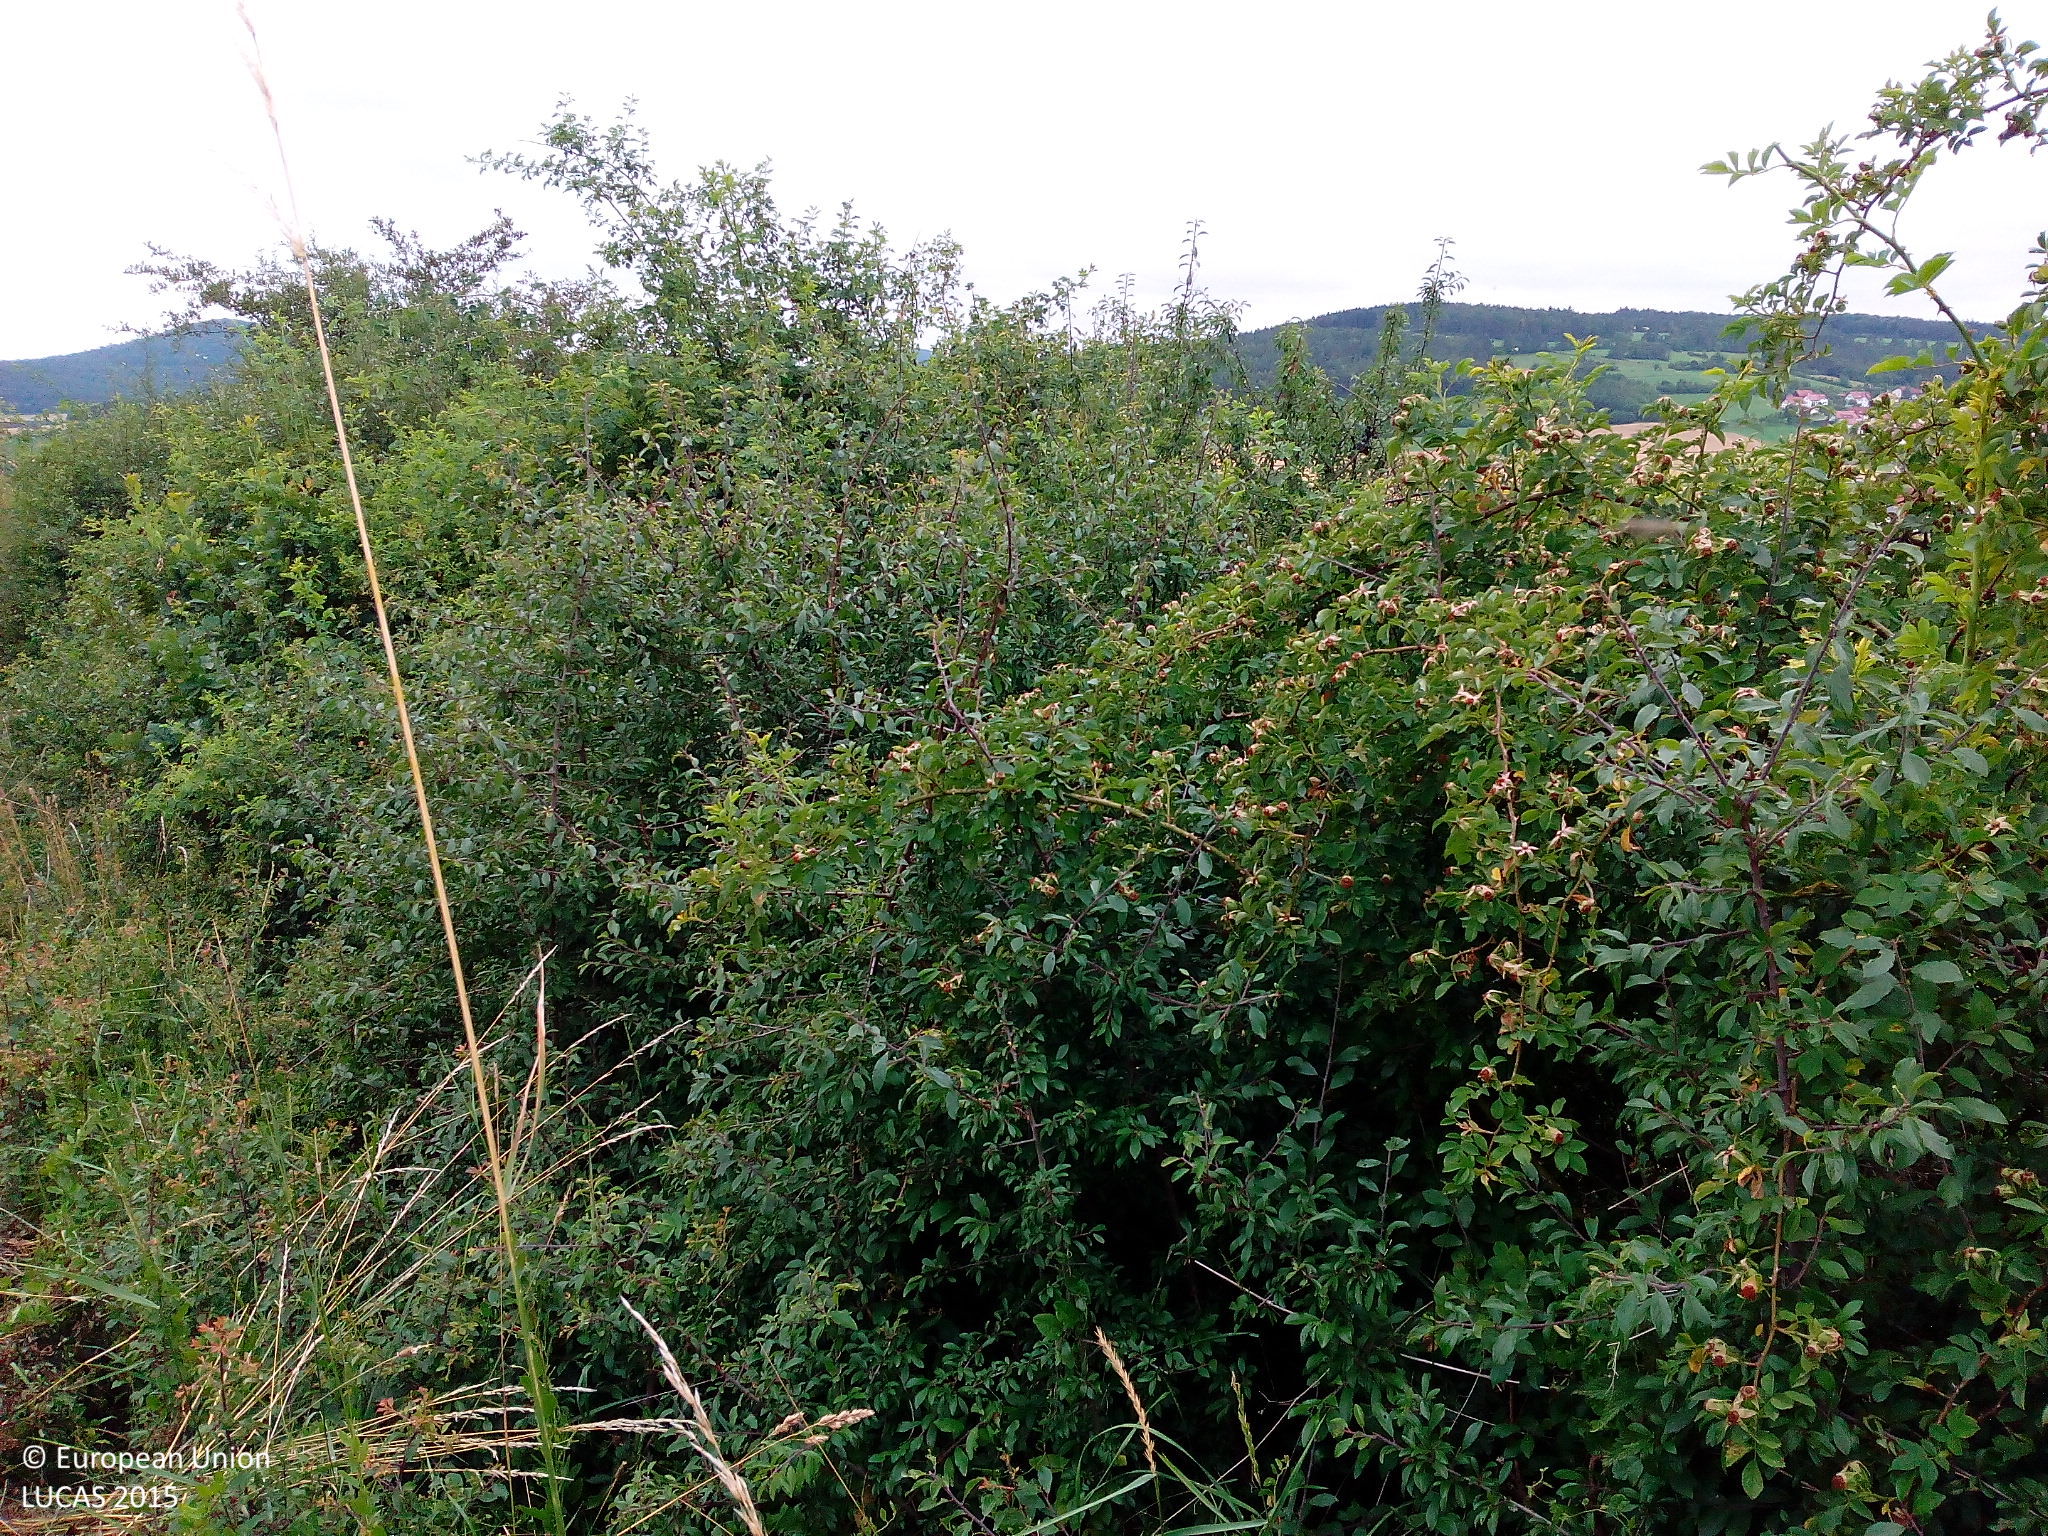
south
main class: Grassland
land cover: Grassland without tree/shrub cover
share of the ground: > 75 %
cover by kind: herbaceous plants 100 %
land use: Agriculture (excluding fallow land and kitchen gardens)
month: July
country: DE
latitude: 50.7775
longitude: 9.8724
